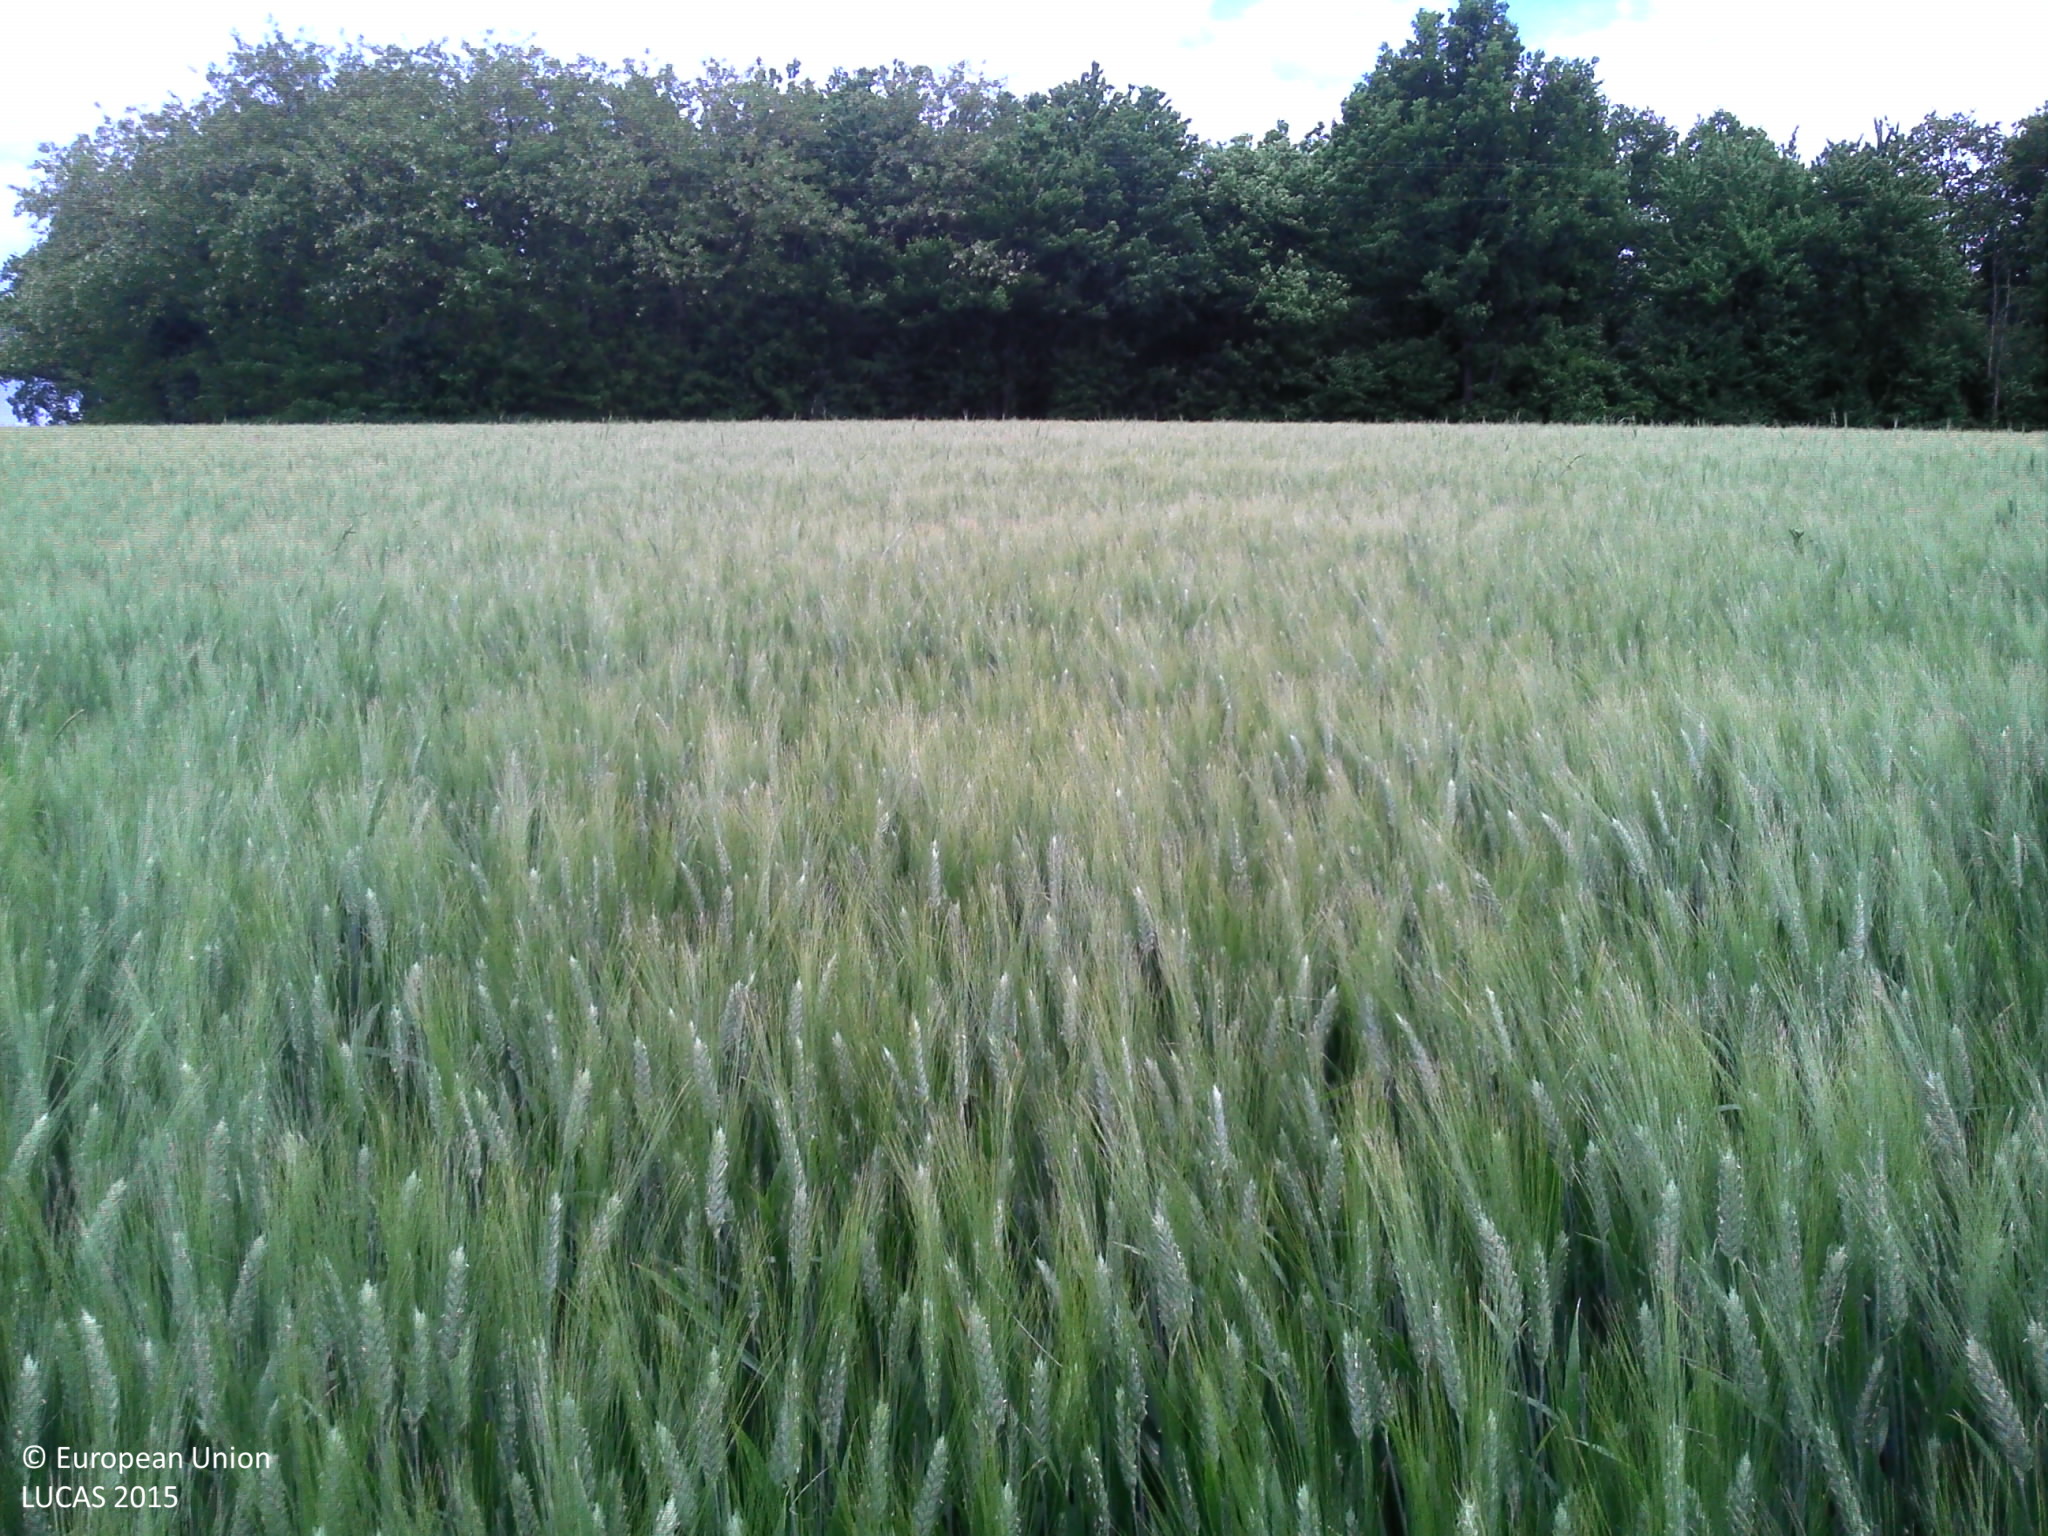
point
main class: Cropland
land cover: Durum wheat
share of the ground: > 75 %
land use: Agriculture (excluding fallow land and kitchen gardens)
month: May
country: FR
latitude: 46.8084
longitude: 0.2161
